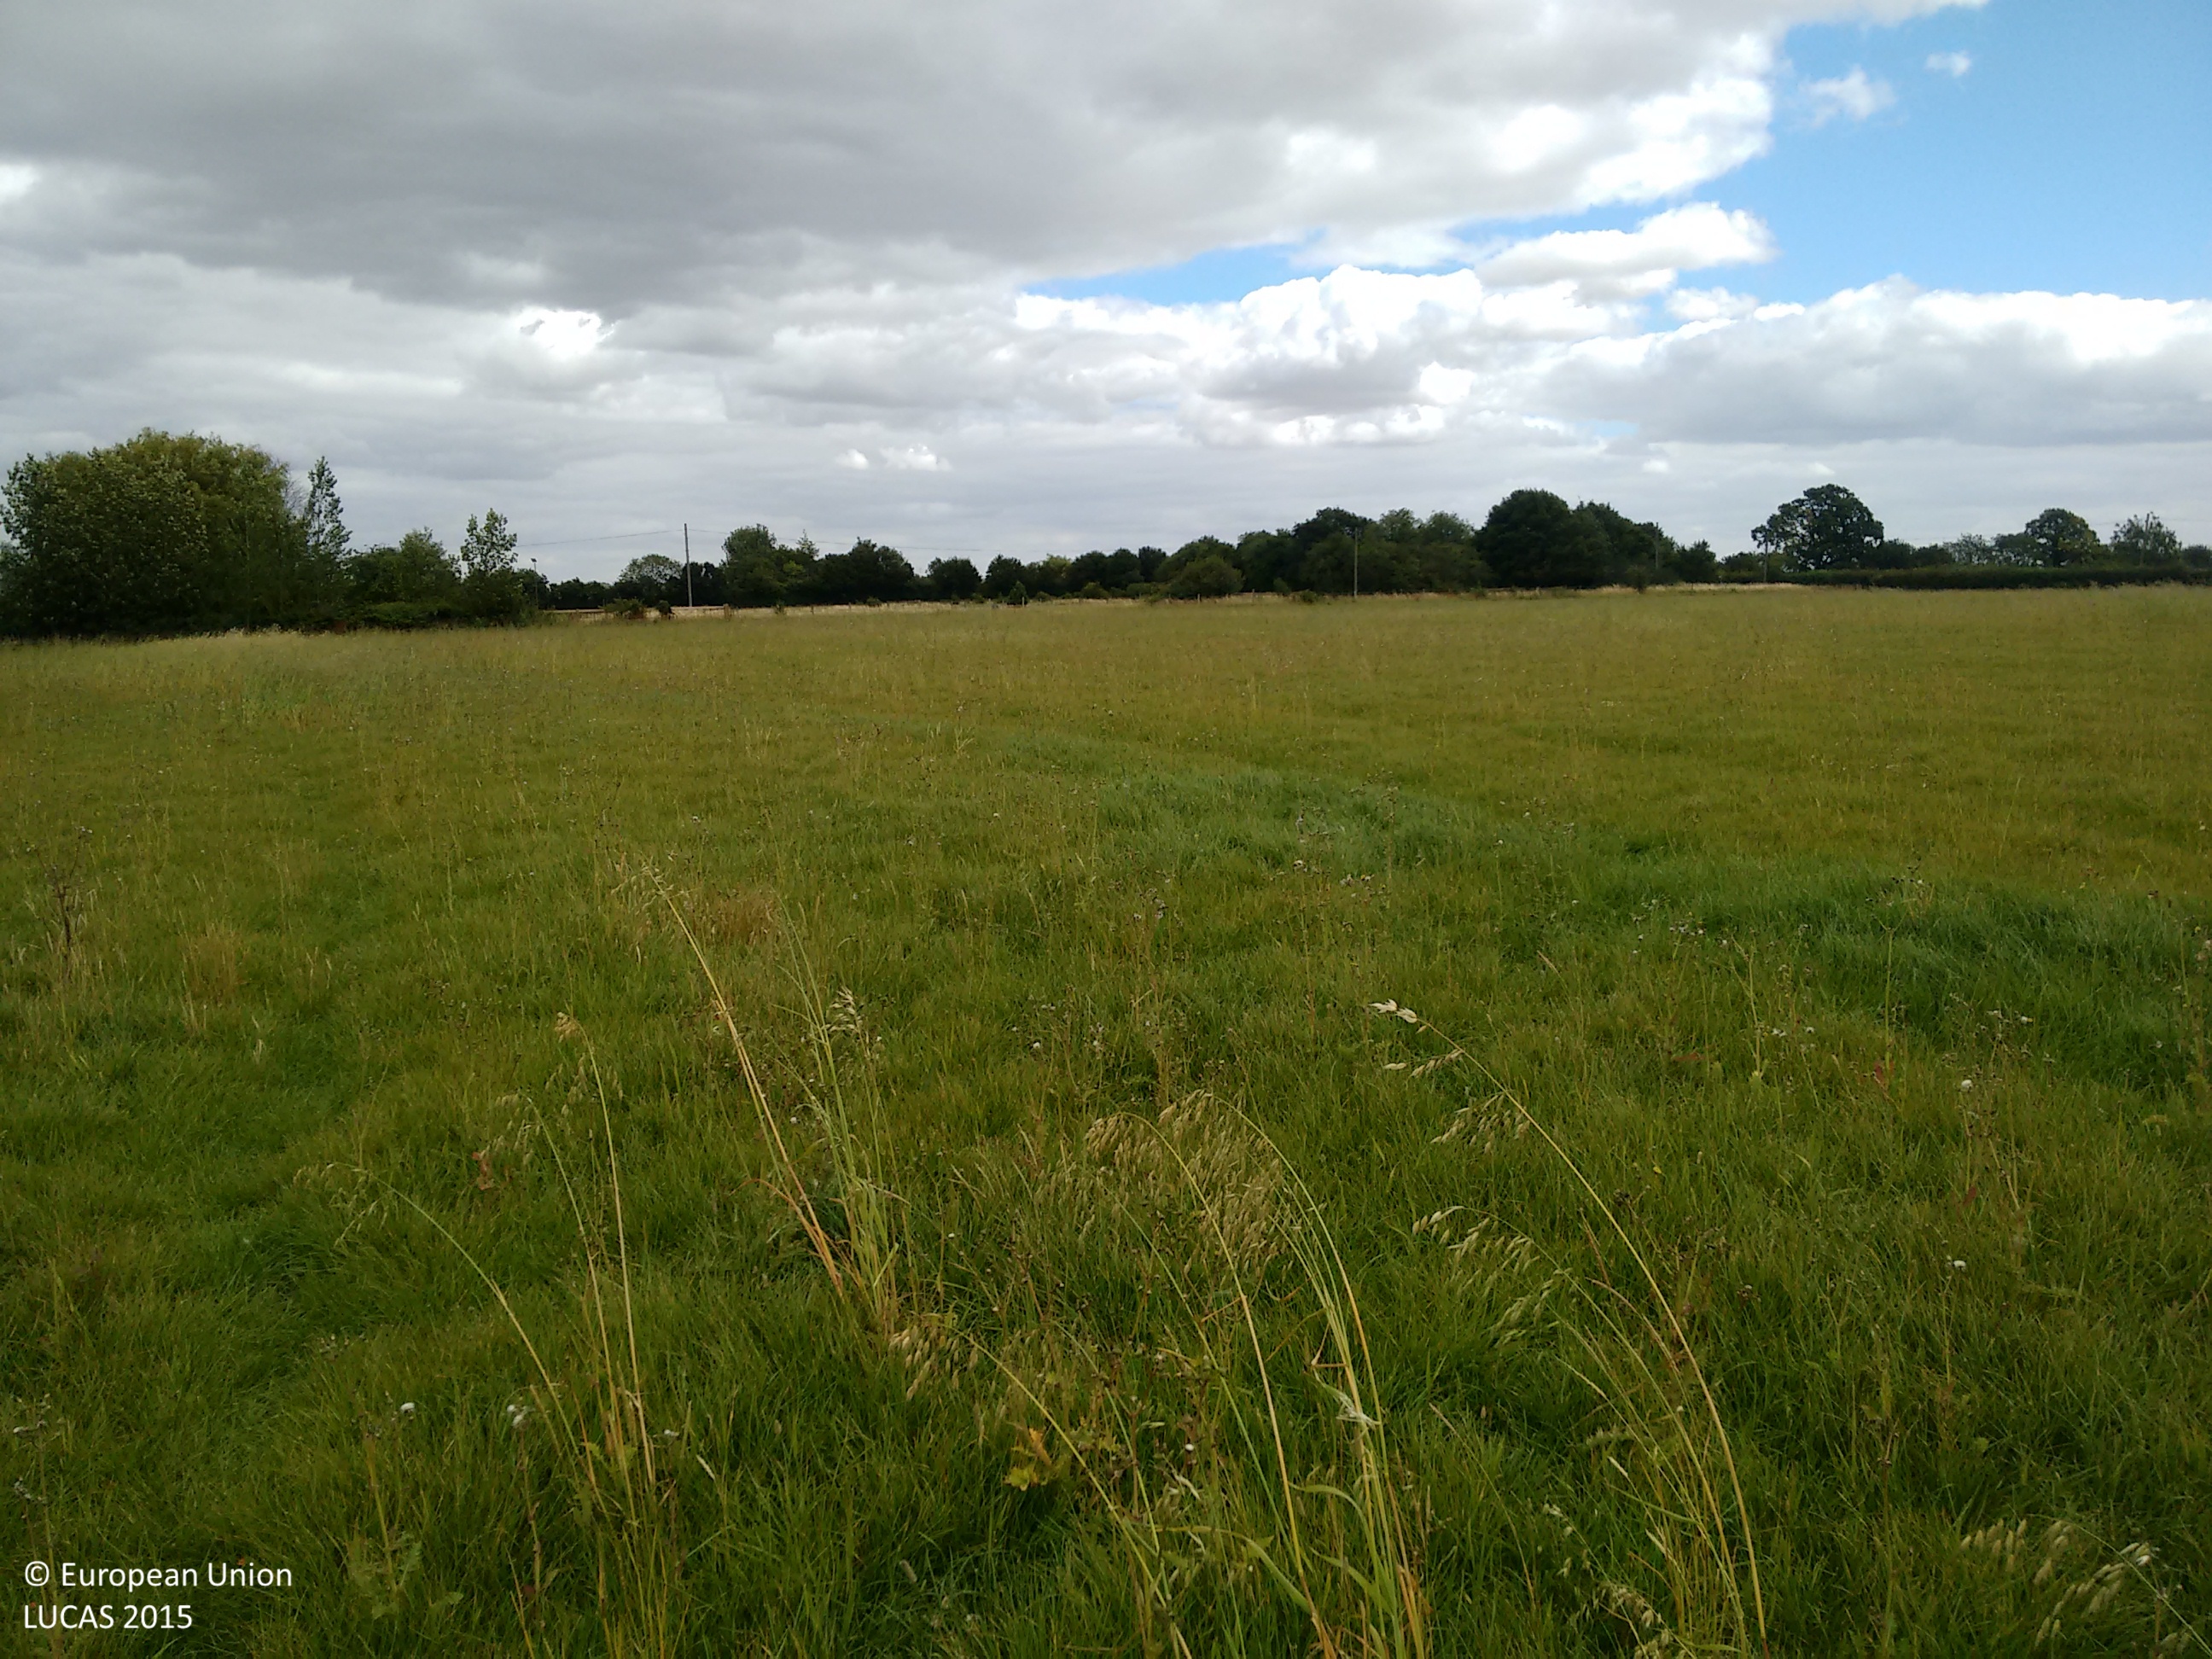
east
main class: Grassland
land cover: Grassland without tree/shrub cover
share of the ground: > 75 %
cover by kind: herbaceous plants 100 %
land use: Agriculture (excluding fallow land and kitchen gardens)
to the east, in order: Grassland without tree/shrub cover; Fences; Grassland without tree/shrub cover; Electric lines; Abandoned hedges; Ditches and canals; Grassland without tree/shrub cover; Fences; Grassland without tree/shrub cover; Fences; Grassland without tree/shrub cover
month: August
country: GB
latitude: 52.0057
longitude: 0.4003
